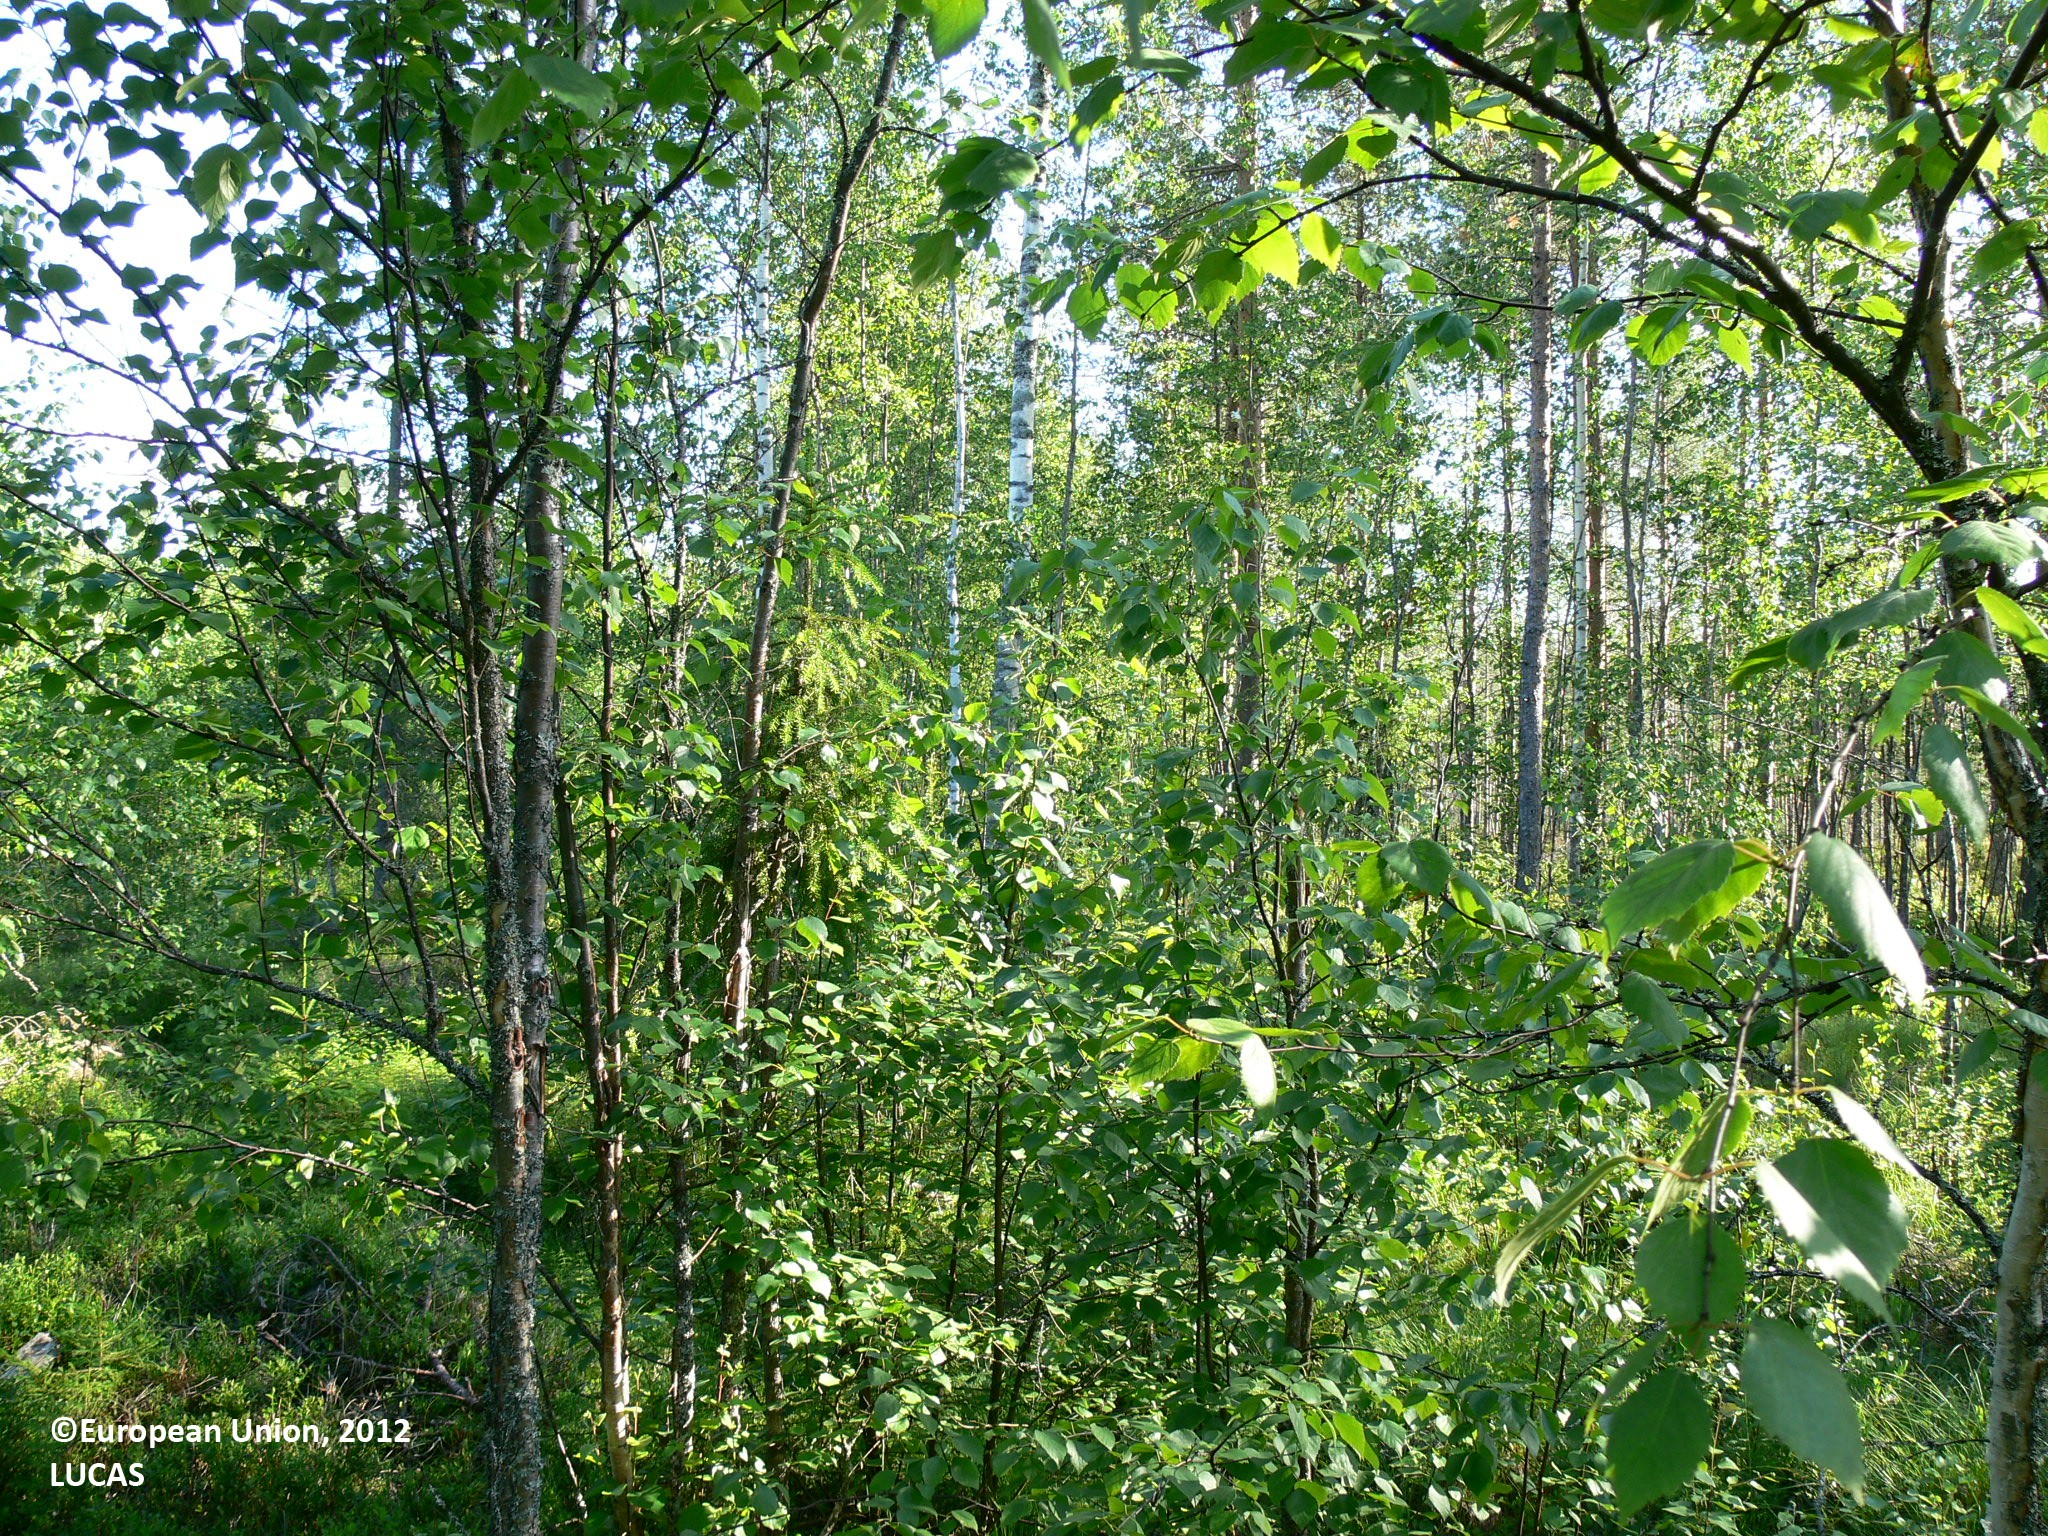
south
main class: Woodland
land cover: Pine dominated mixed woodland
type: boreal forest
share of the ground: > 75 %
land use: Forestry
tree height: > 5 m
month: July
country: FI
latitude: 62.8842
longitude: 30.7619
